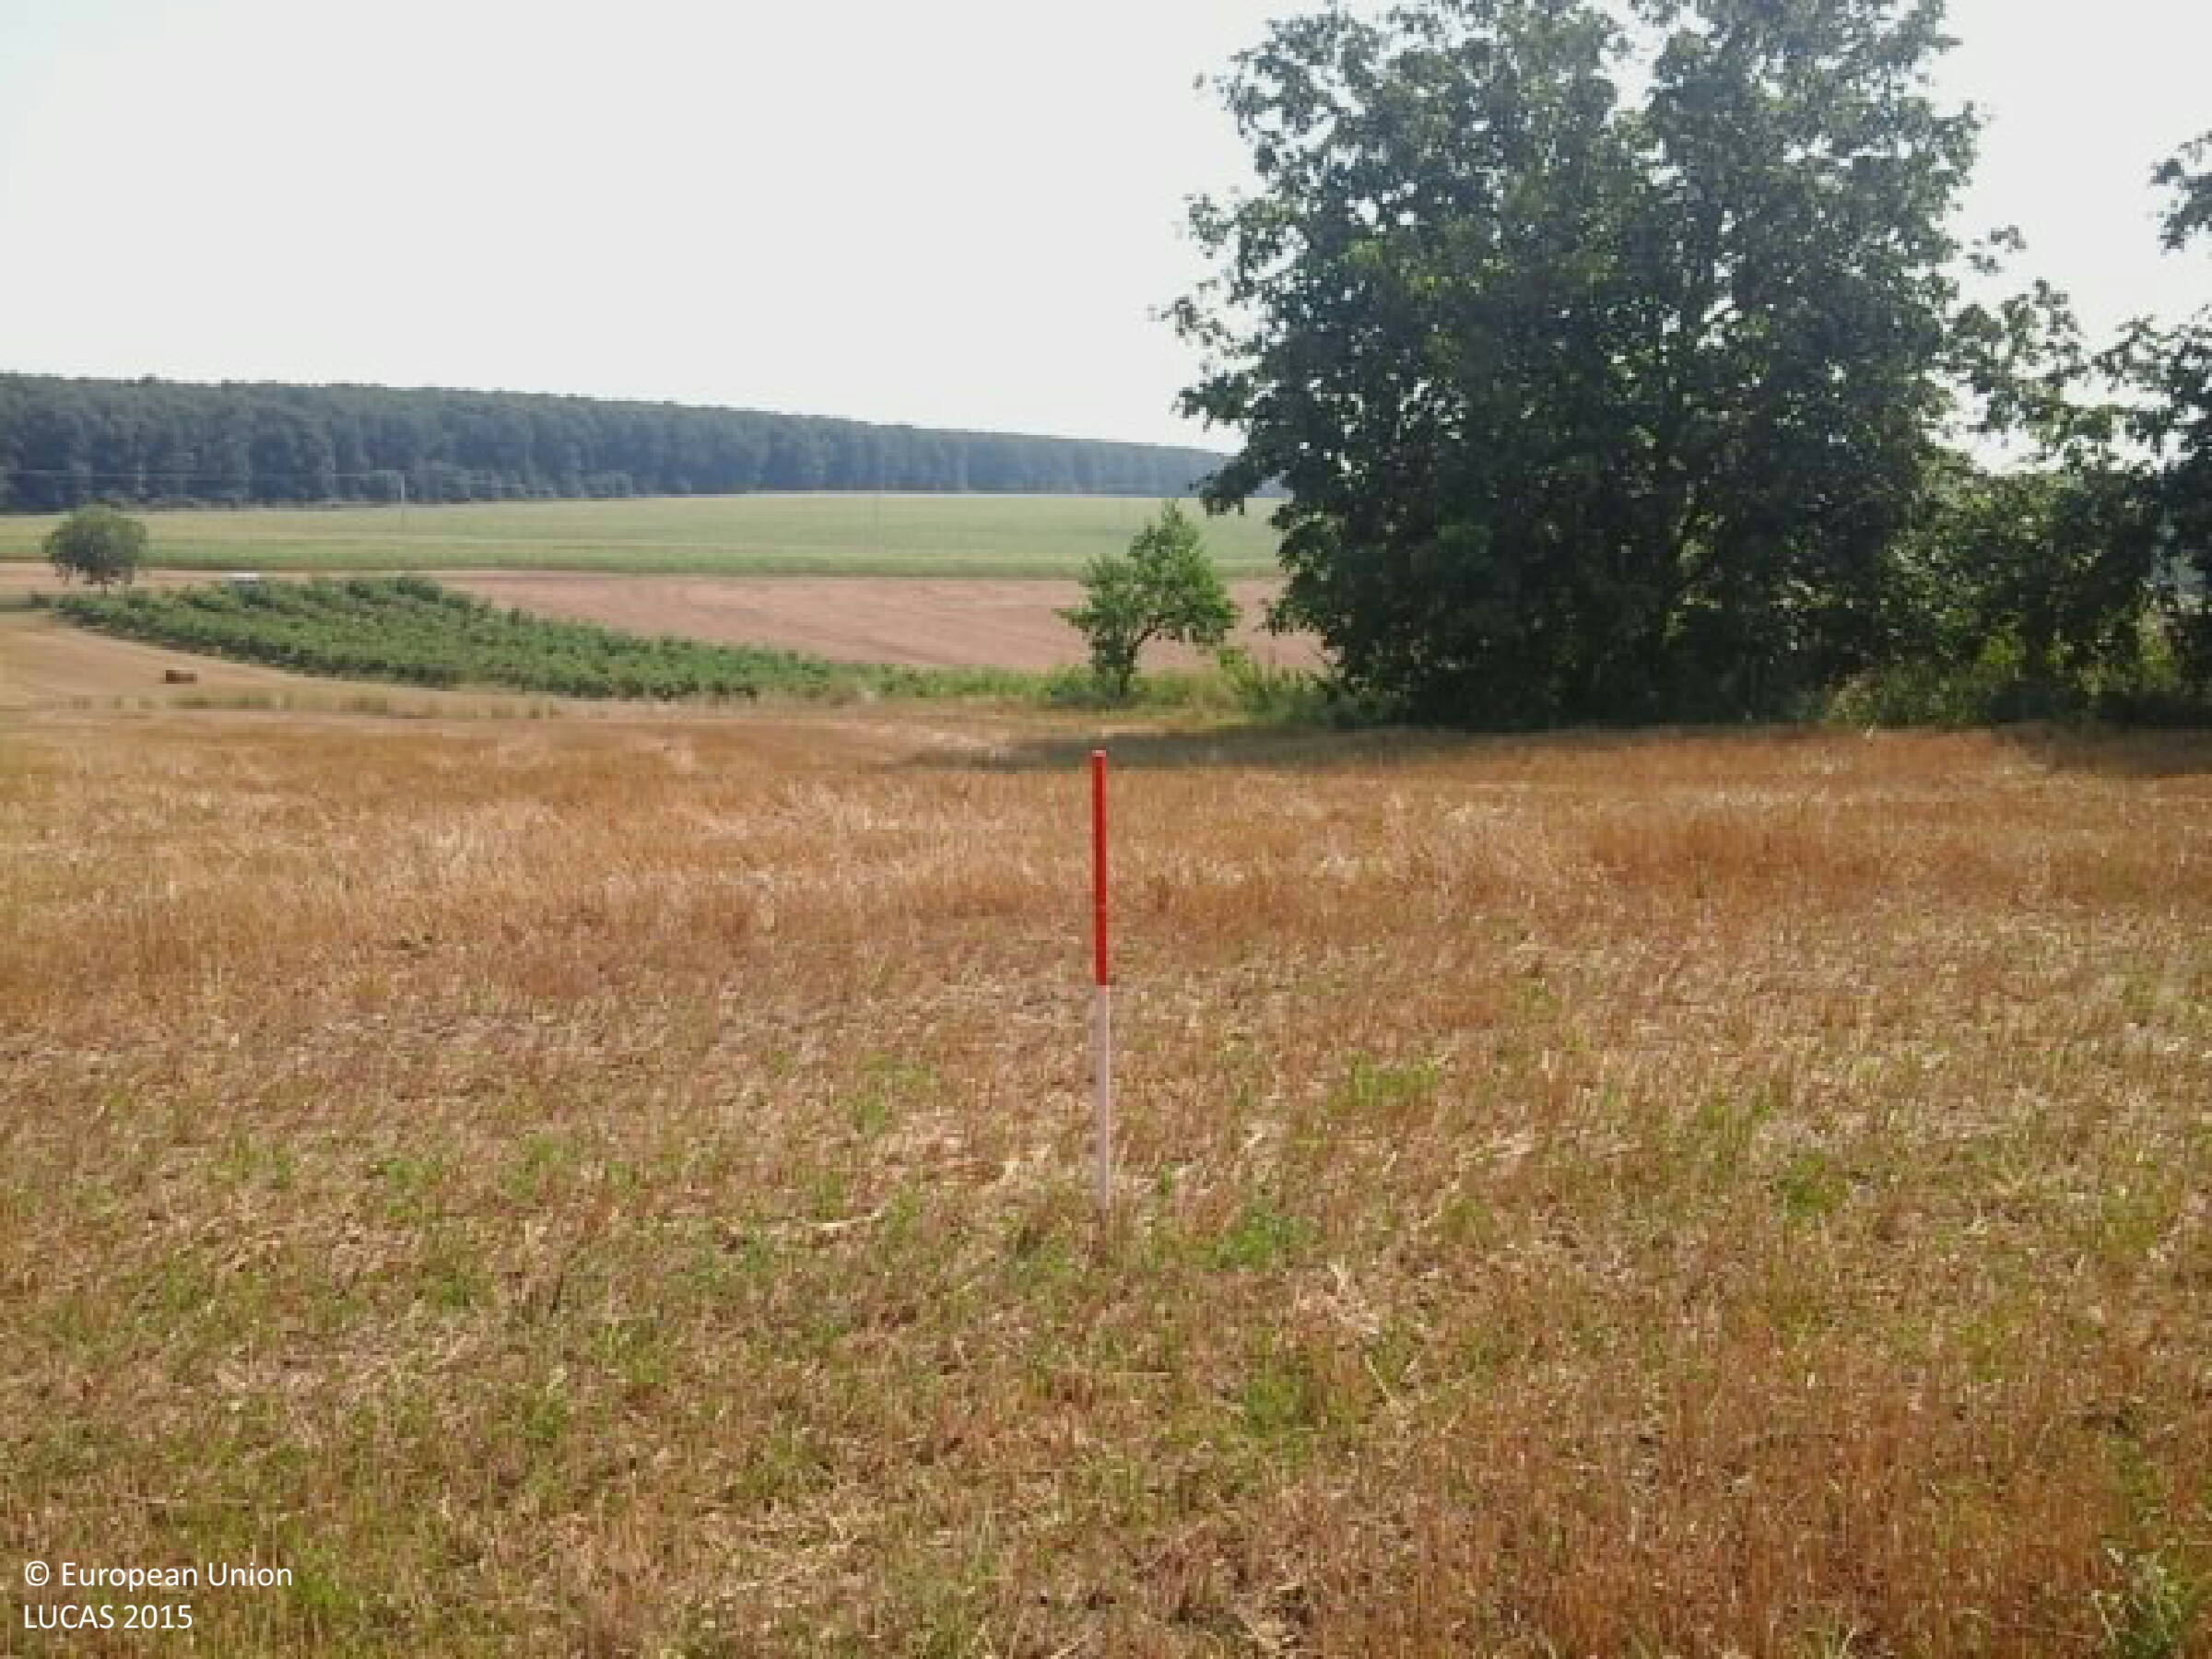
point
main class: Cropland
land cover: Common wheat
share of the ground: 50 - 75 %
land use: Agriculture (excluding fallow land and kitchen gardens)
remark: Harvested field
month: August
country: HU
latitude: 46.3153
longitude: 18.3329
